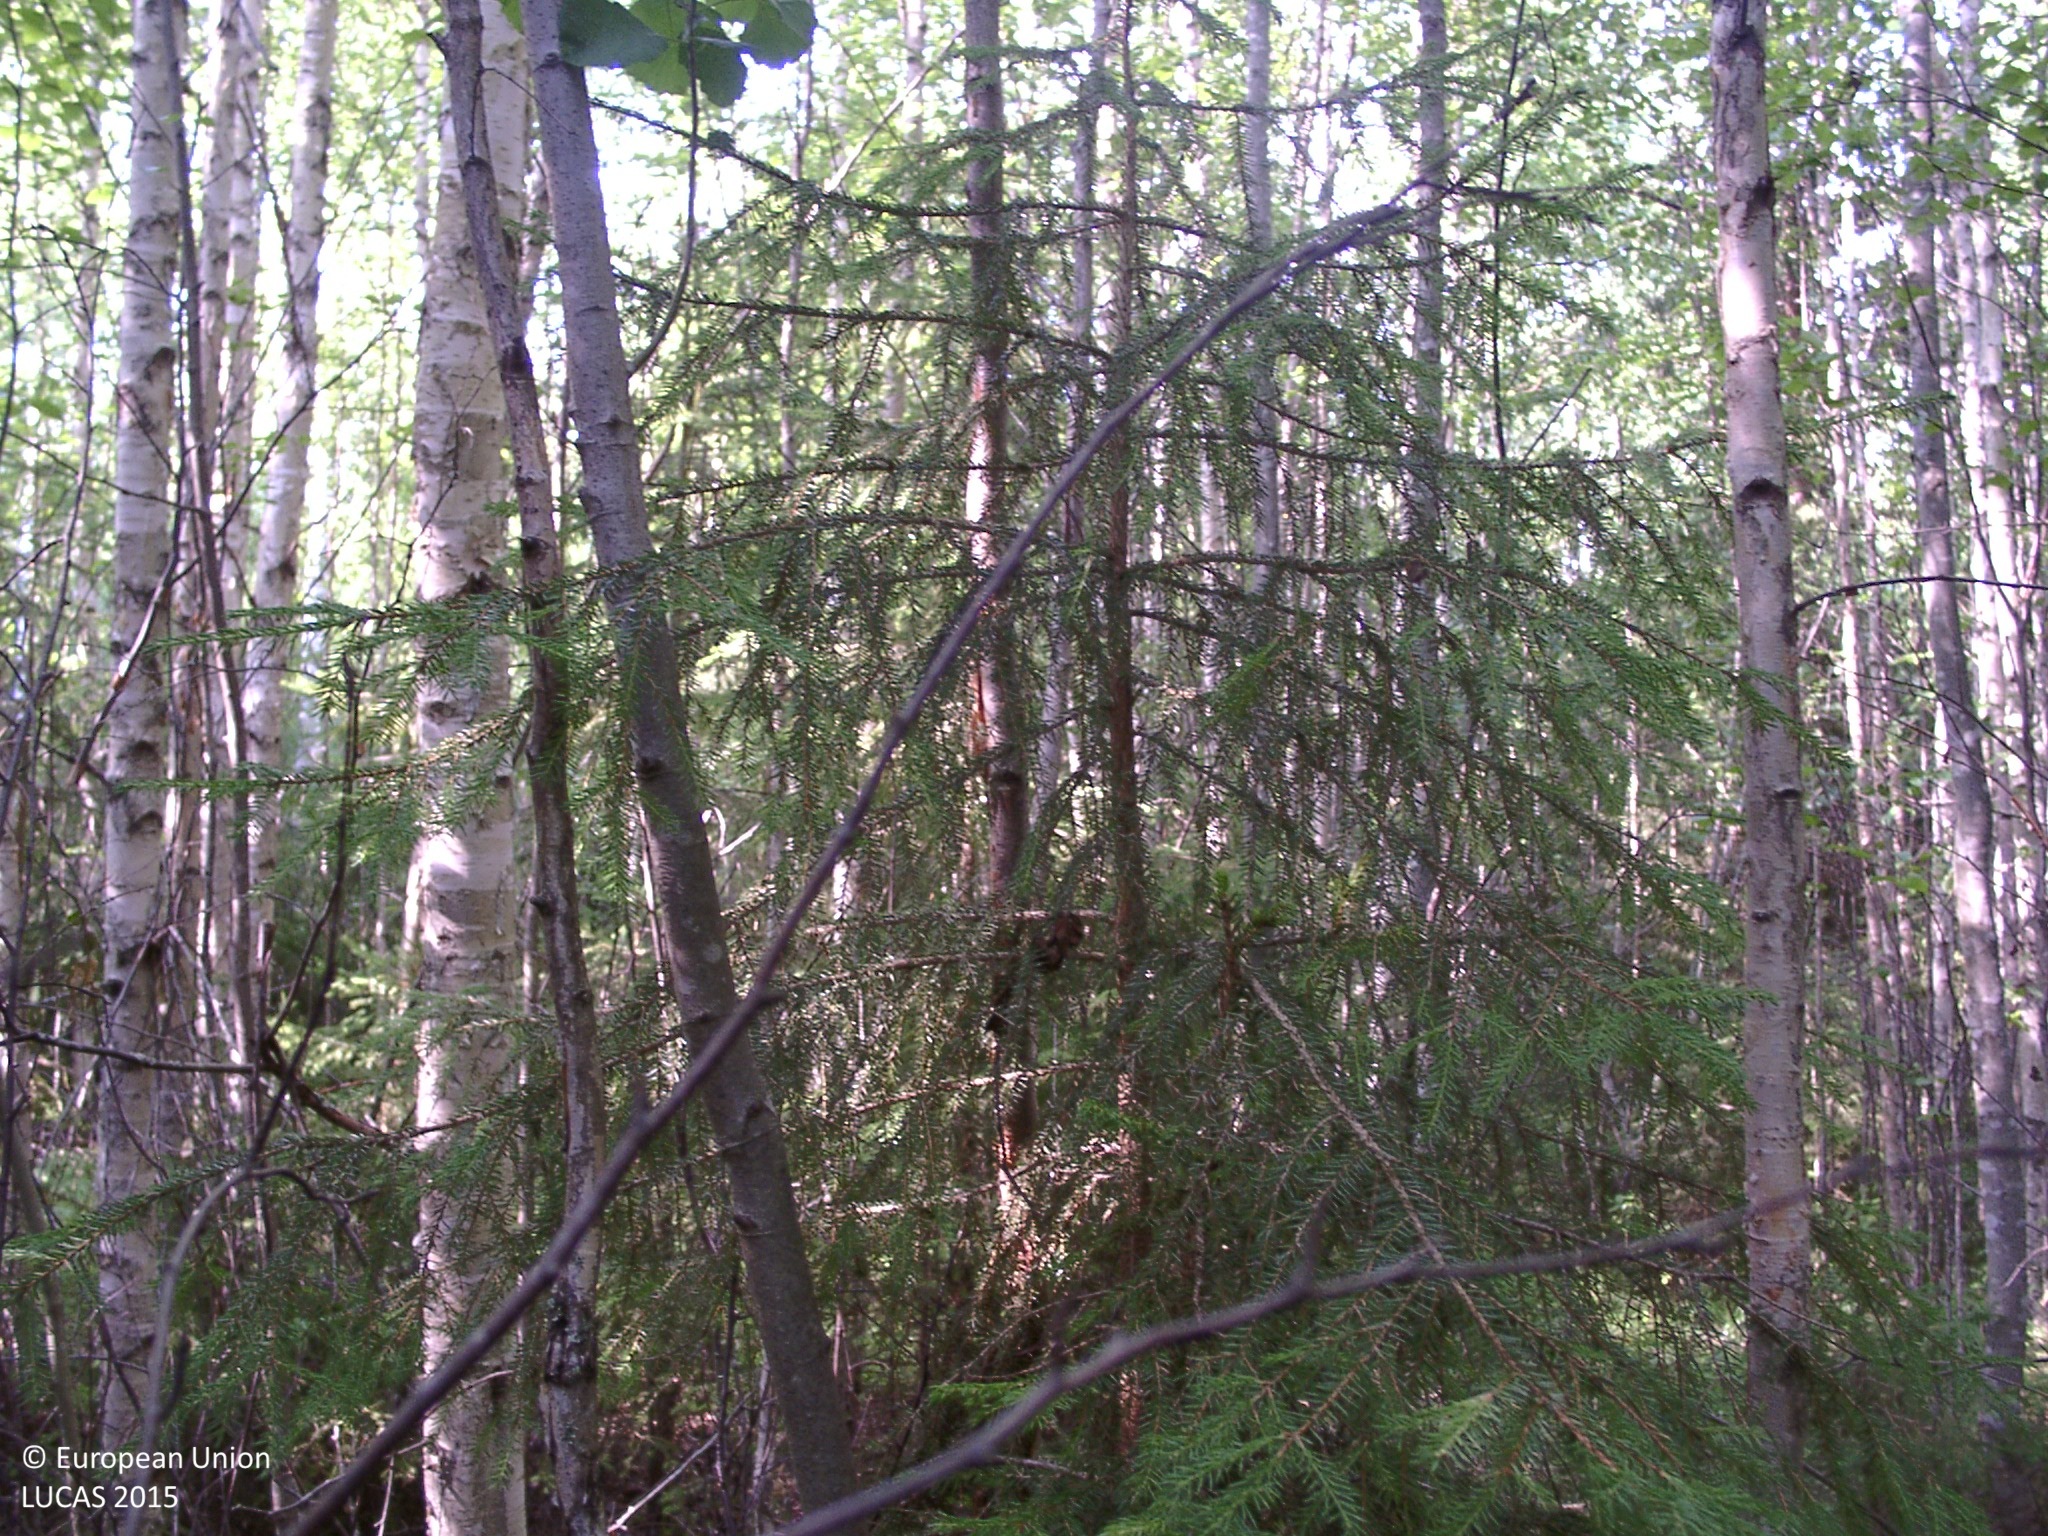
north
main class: Woodland
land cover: Spruce dominated mixed woodland
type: boreal forest
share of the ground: > 75 %
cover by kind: broadleaved forest trees 60 %, coniferous forest trees 25 %, herbaceous plants 10 %, unconsolidated bare surface 5 %
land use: Forestry
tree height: > 5 m
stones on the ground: < 10 %
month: July
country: FI
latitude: 61.5860
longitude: 25.2803
